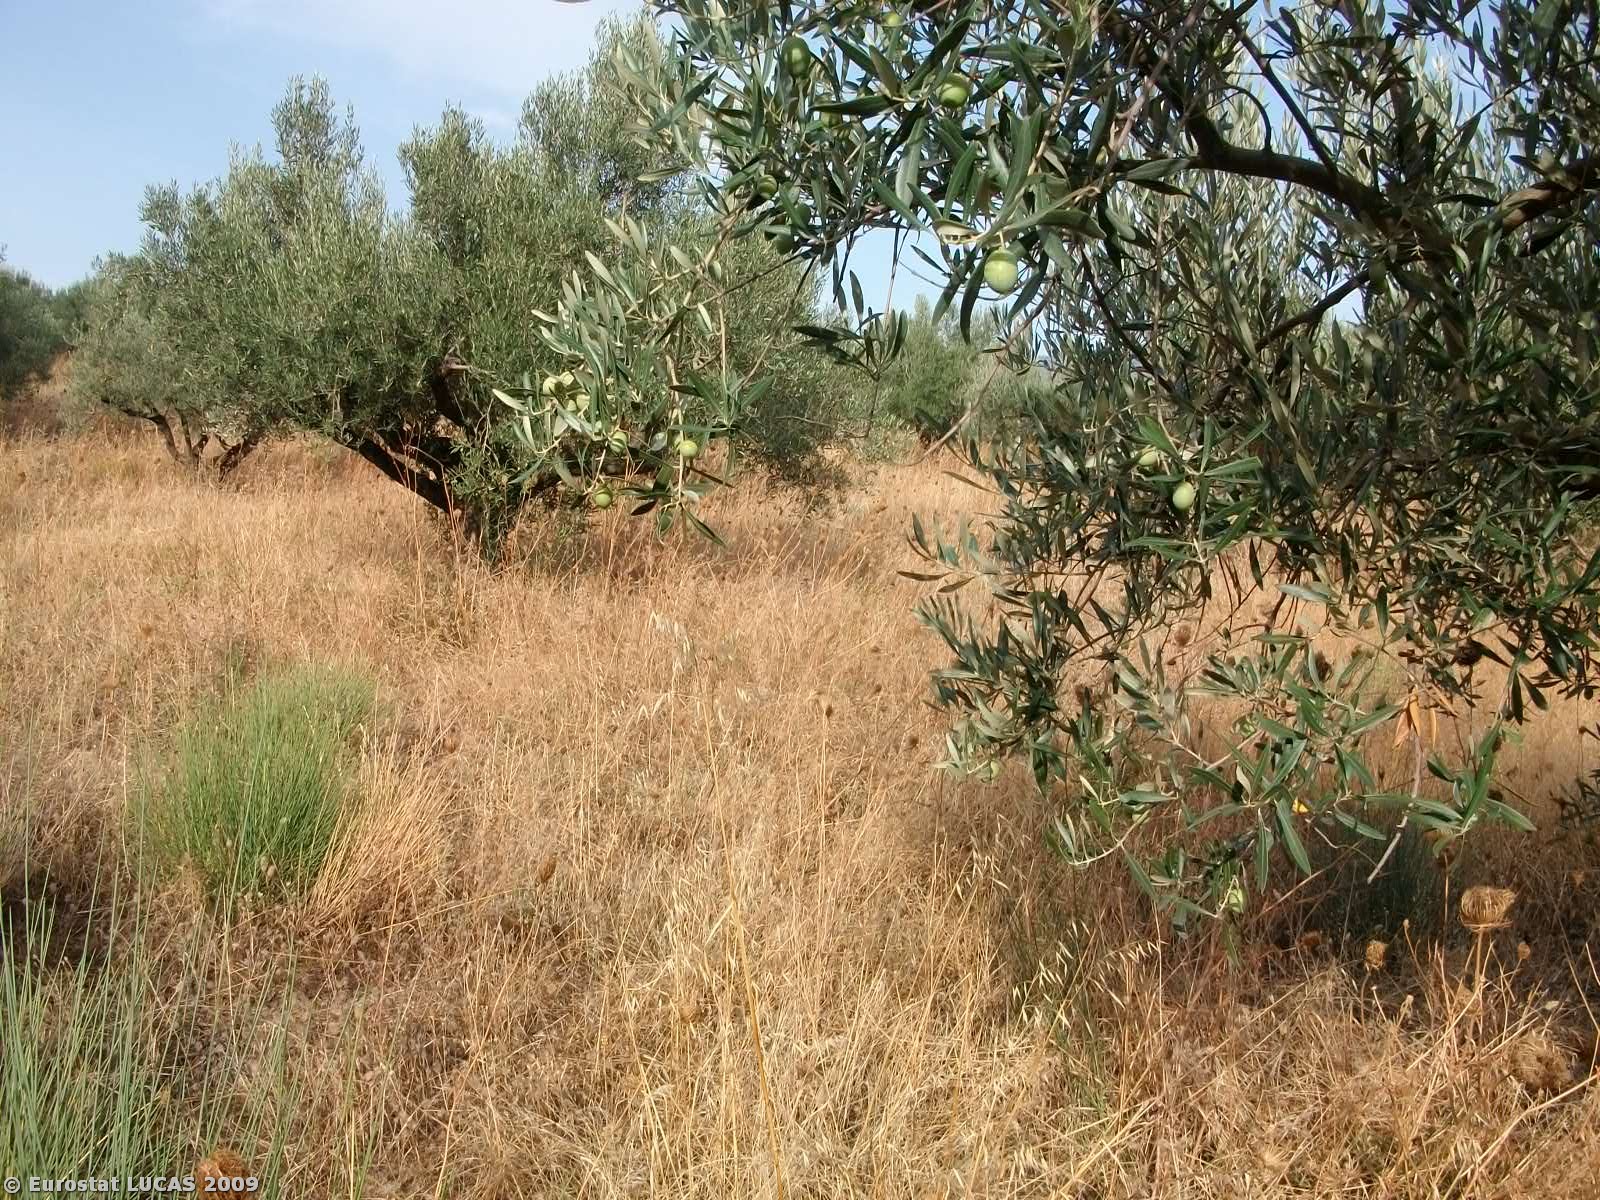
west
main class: Cropland
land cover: Olive groves
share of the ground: 10 - 25 %
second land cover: Grassland with sparse tree/shrub cover
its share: > 75 %
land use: Agriculture (excluding fallow land and kitchen gardens)
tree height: < 5 m
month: September
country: GR
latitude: 38.0649
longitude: 22.5657
